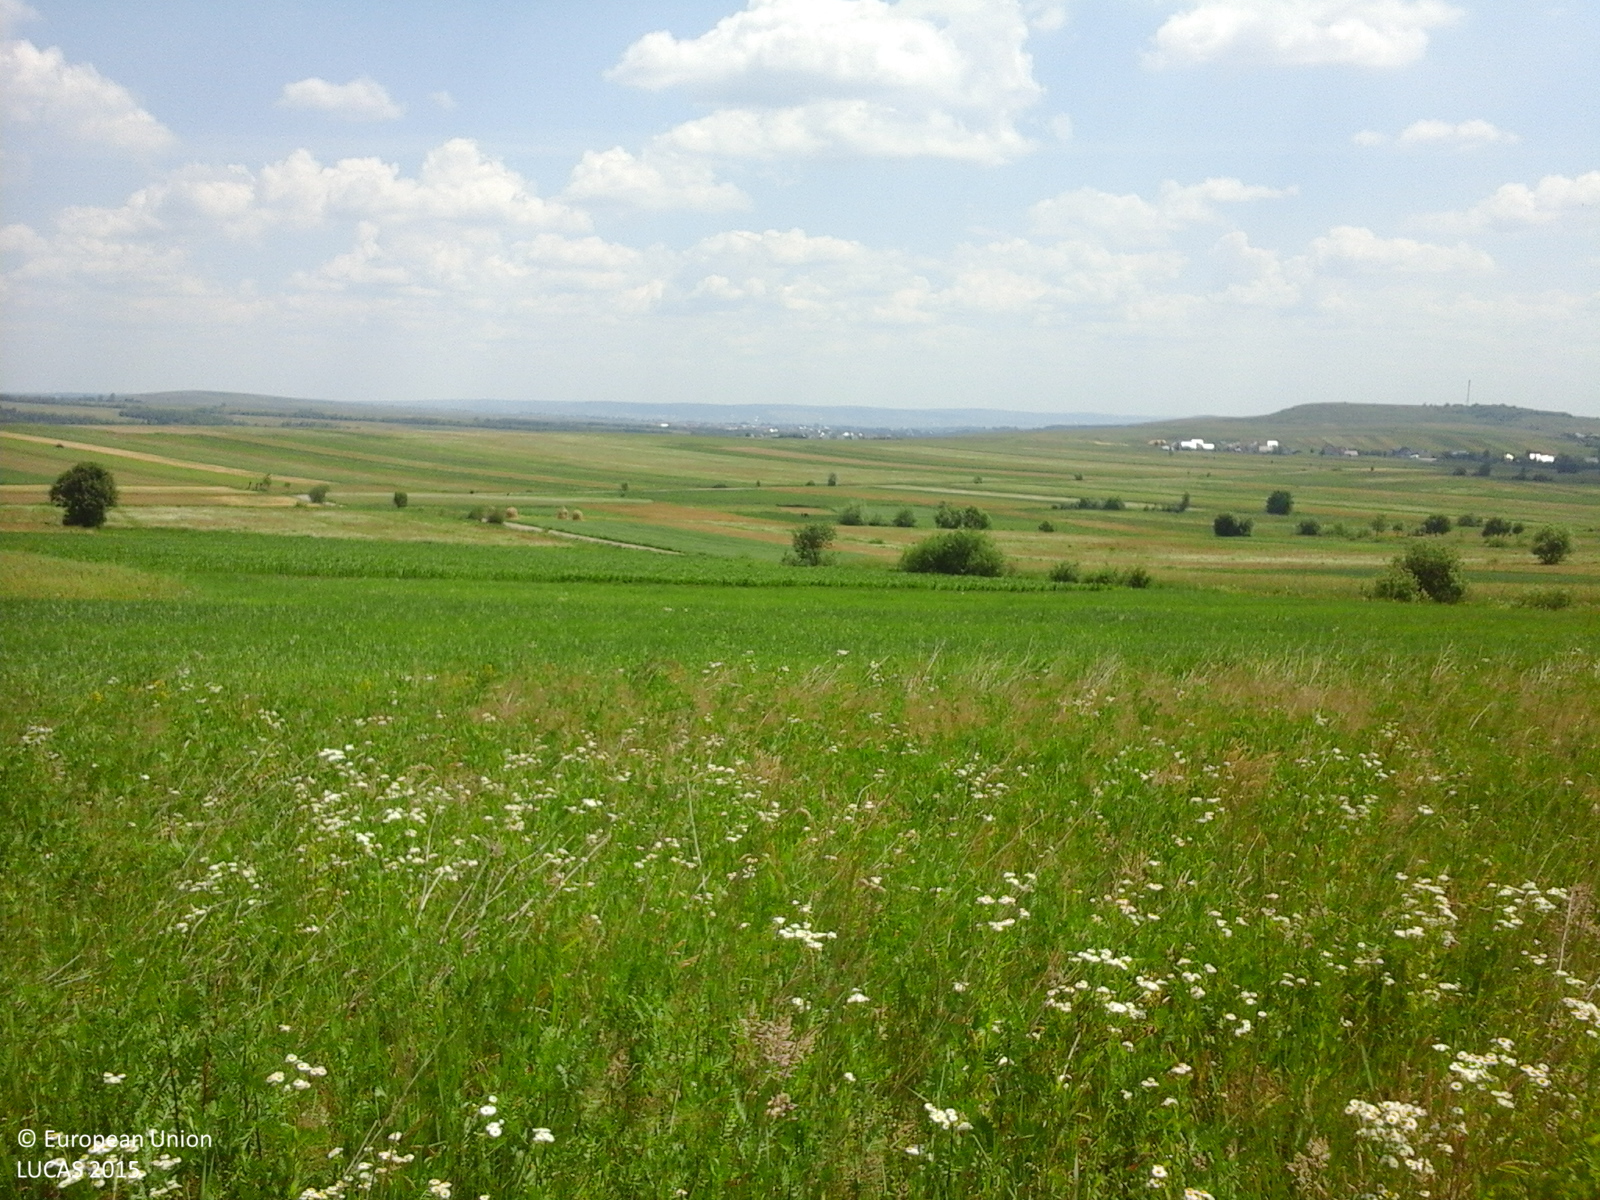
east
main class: Grassland
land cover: Grassland without tree/shrub cover
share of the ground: > 75 %
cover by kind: herbaceous plants 100 %
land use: Agriculture (excluding fallow land and kitchen gardens)
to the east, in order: Grassland without tree/shrub cover; Oats; Maize; Grass margins; Ditches and canals; Tracks; Grass margins; Barley; Oats; Grassland without tree/shrub cover
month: June
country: RO
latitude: 47.7592
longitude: 25.8829
